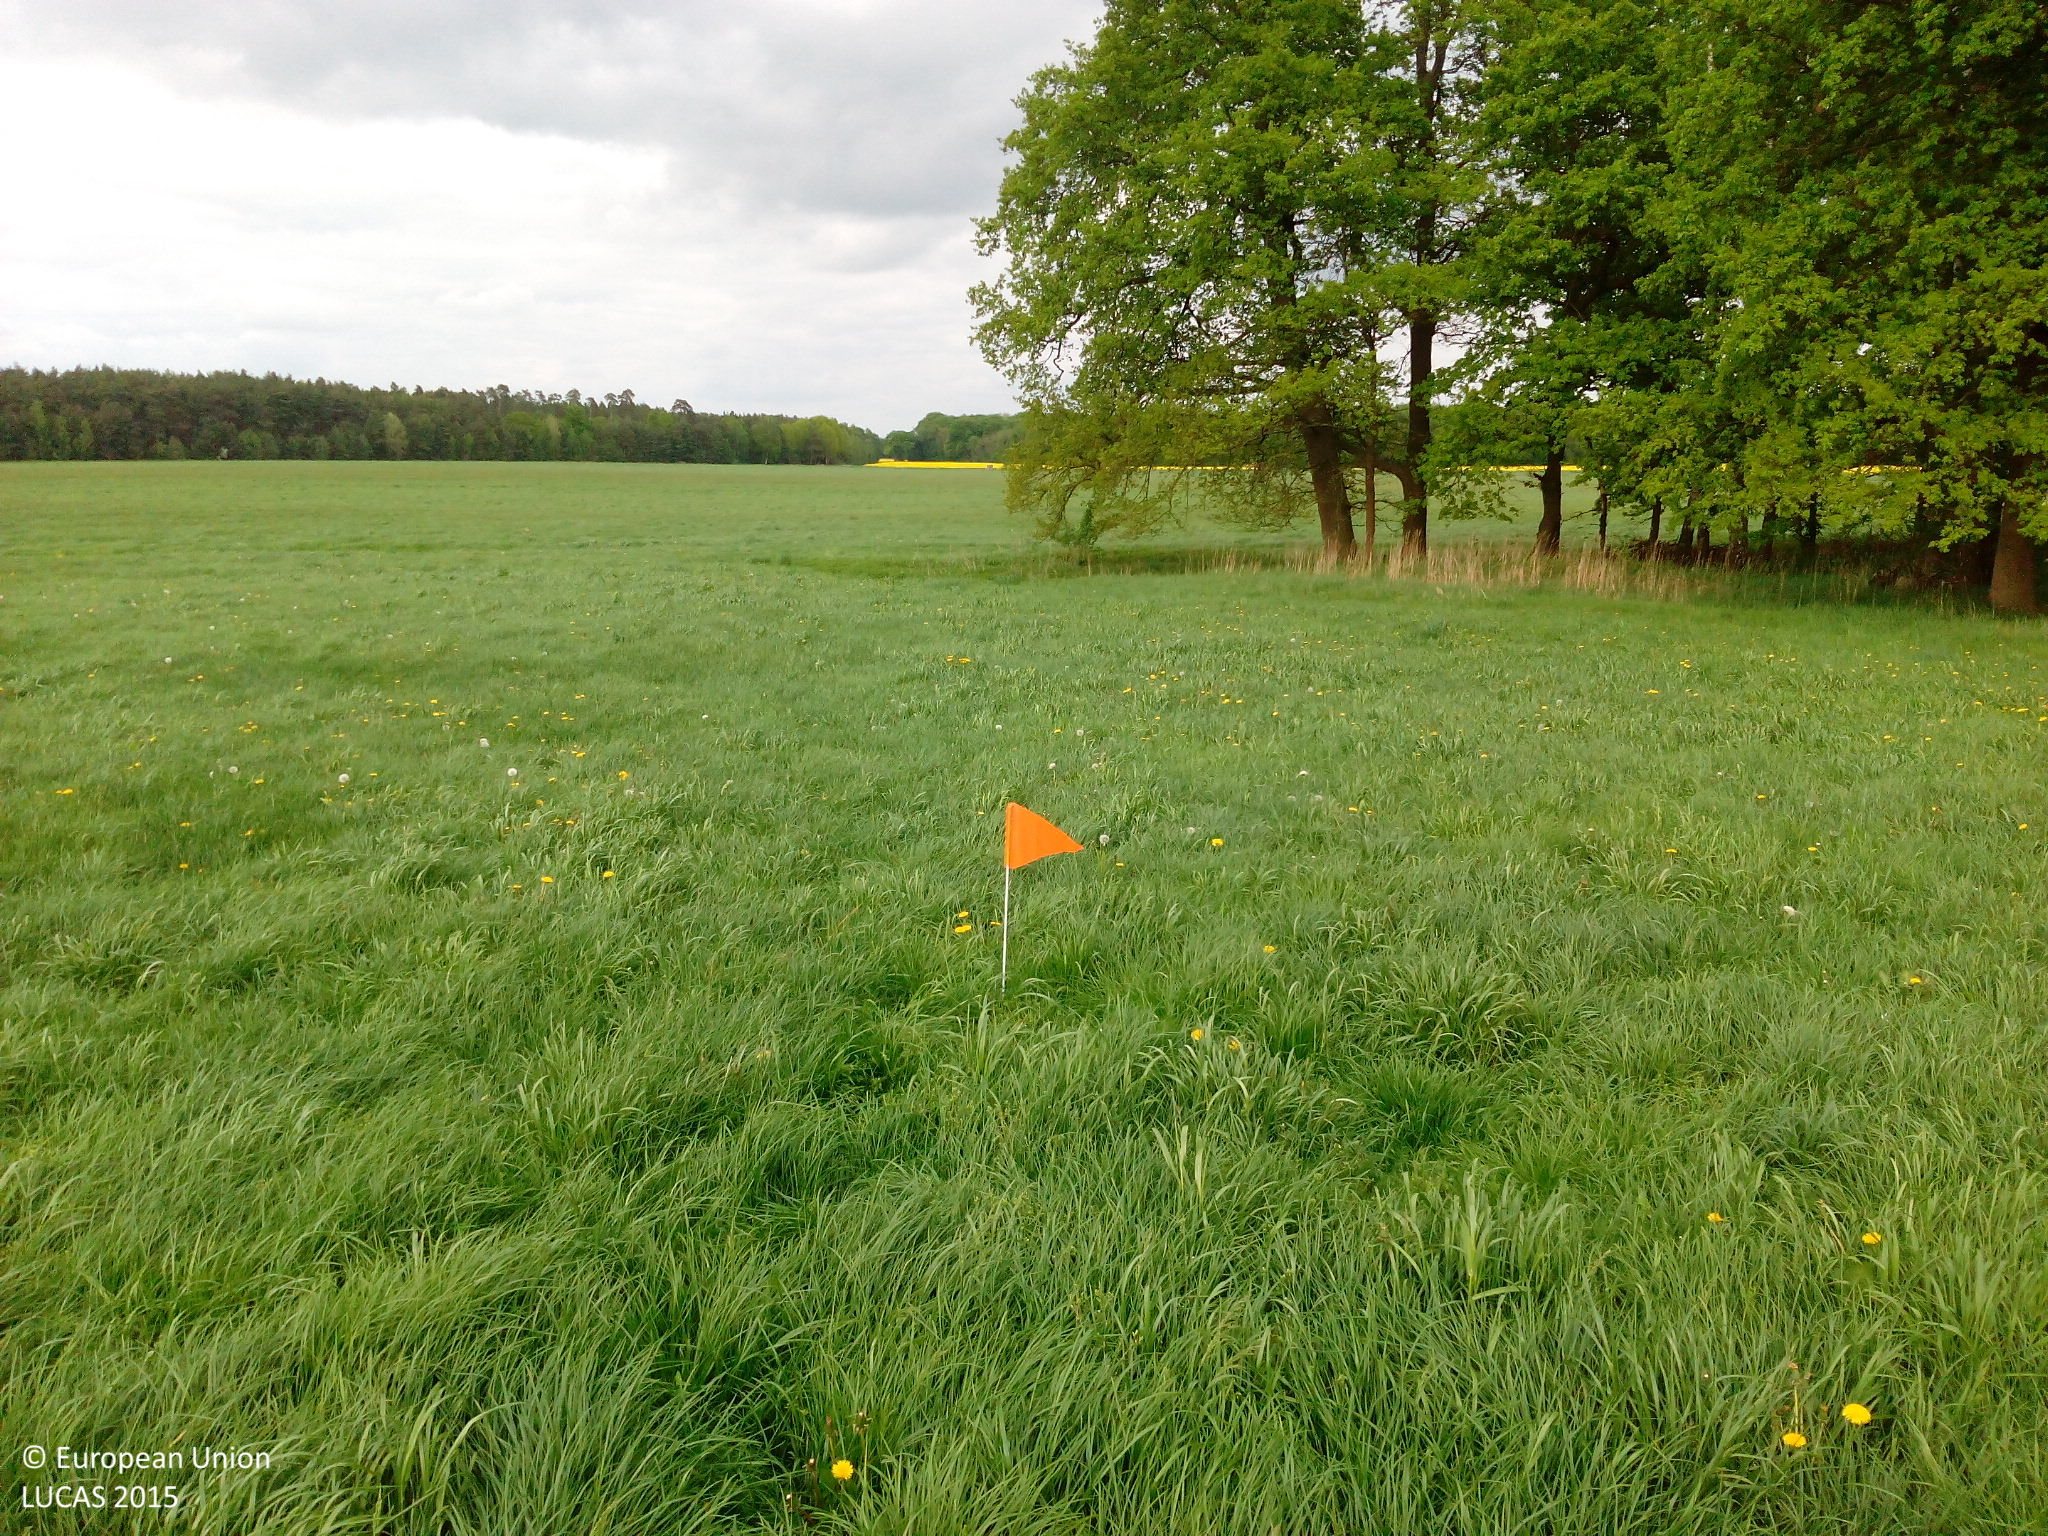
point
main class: Grassland
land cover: Grassland without tree/shrub cover
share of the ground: > 75 %
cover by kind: herbaceous plants 100 %
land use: Agriculture (excluding fallow land and kitchen gardens)
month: May
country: DE
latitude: 52.8518
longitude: 11.6181
